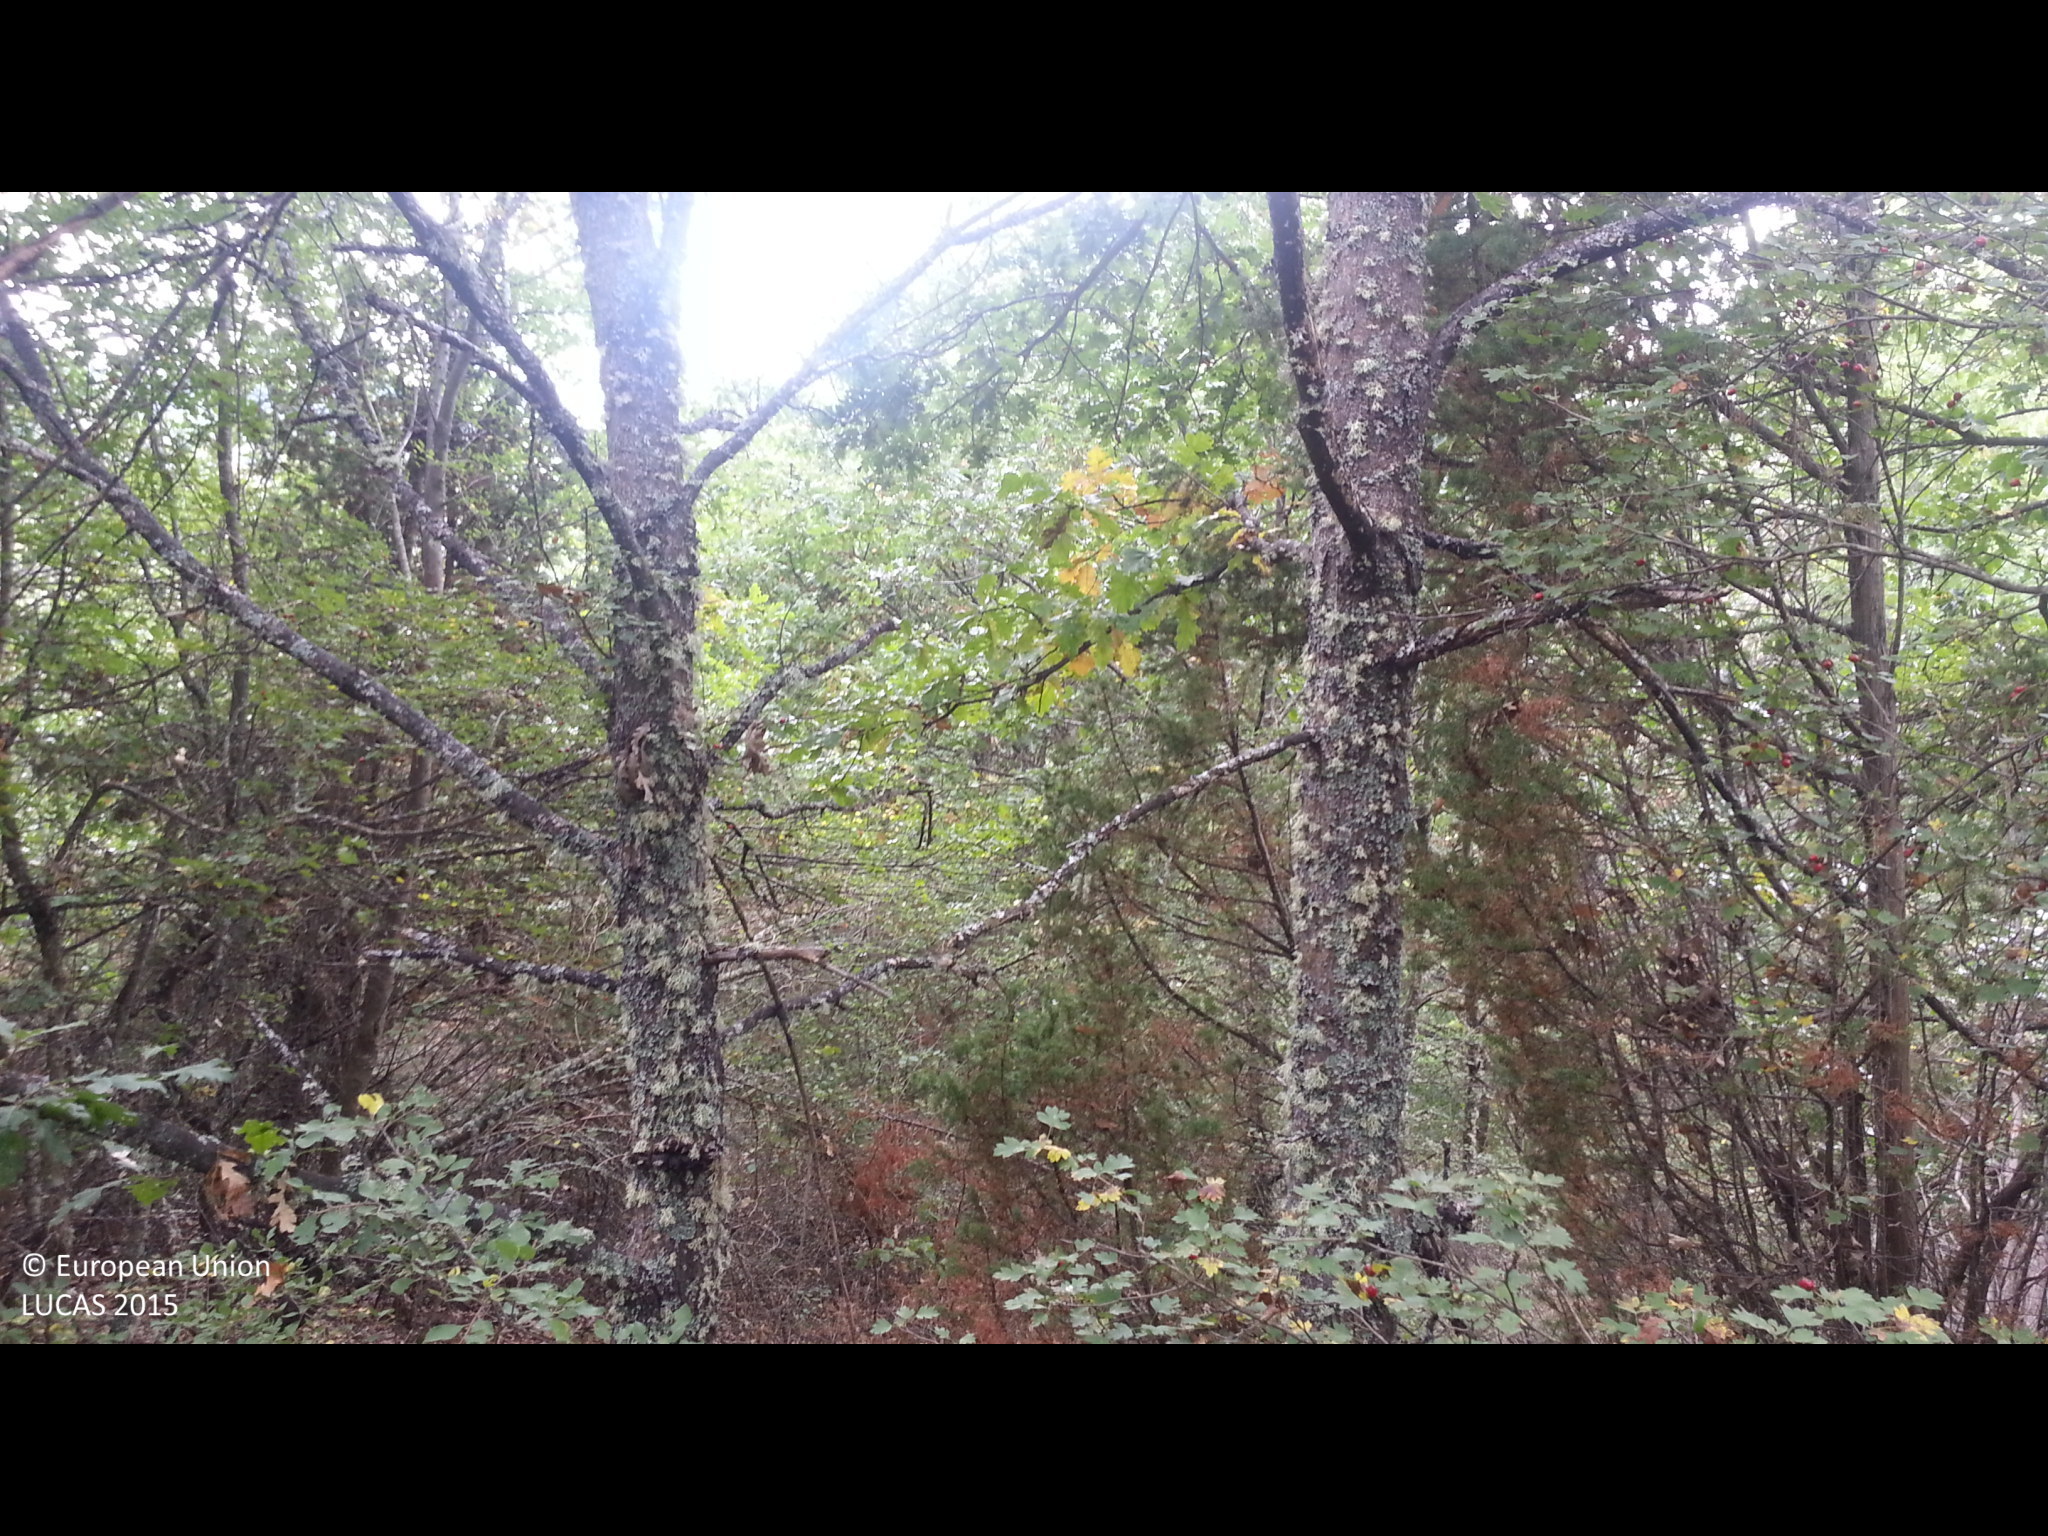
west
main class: Woodland
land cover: Broadleaved woodland
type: mesophytic deciduous forest
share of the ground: > 75 %
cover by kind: broadleaved forest trees 85 %, shrubs 10 %, coniferous forest trees 5 %
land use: Forestry
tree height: > 5 m
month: September
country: BG
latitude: 42.3760
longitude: 22.5910
